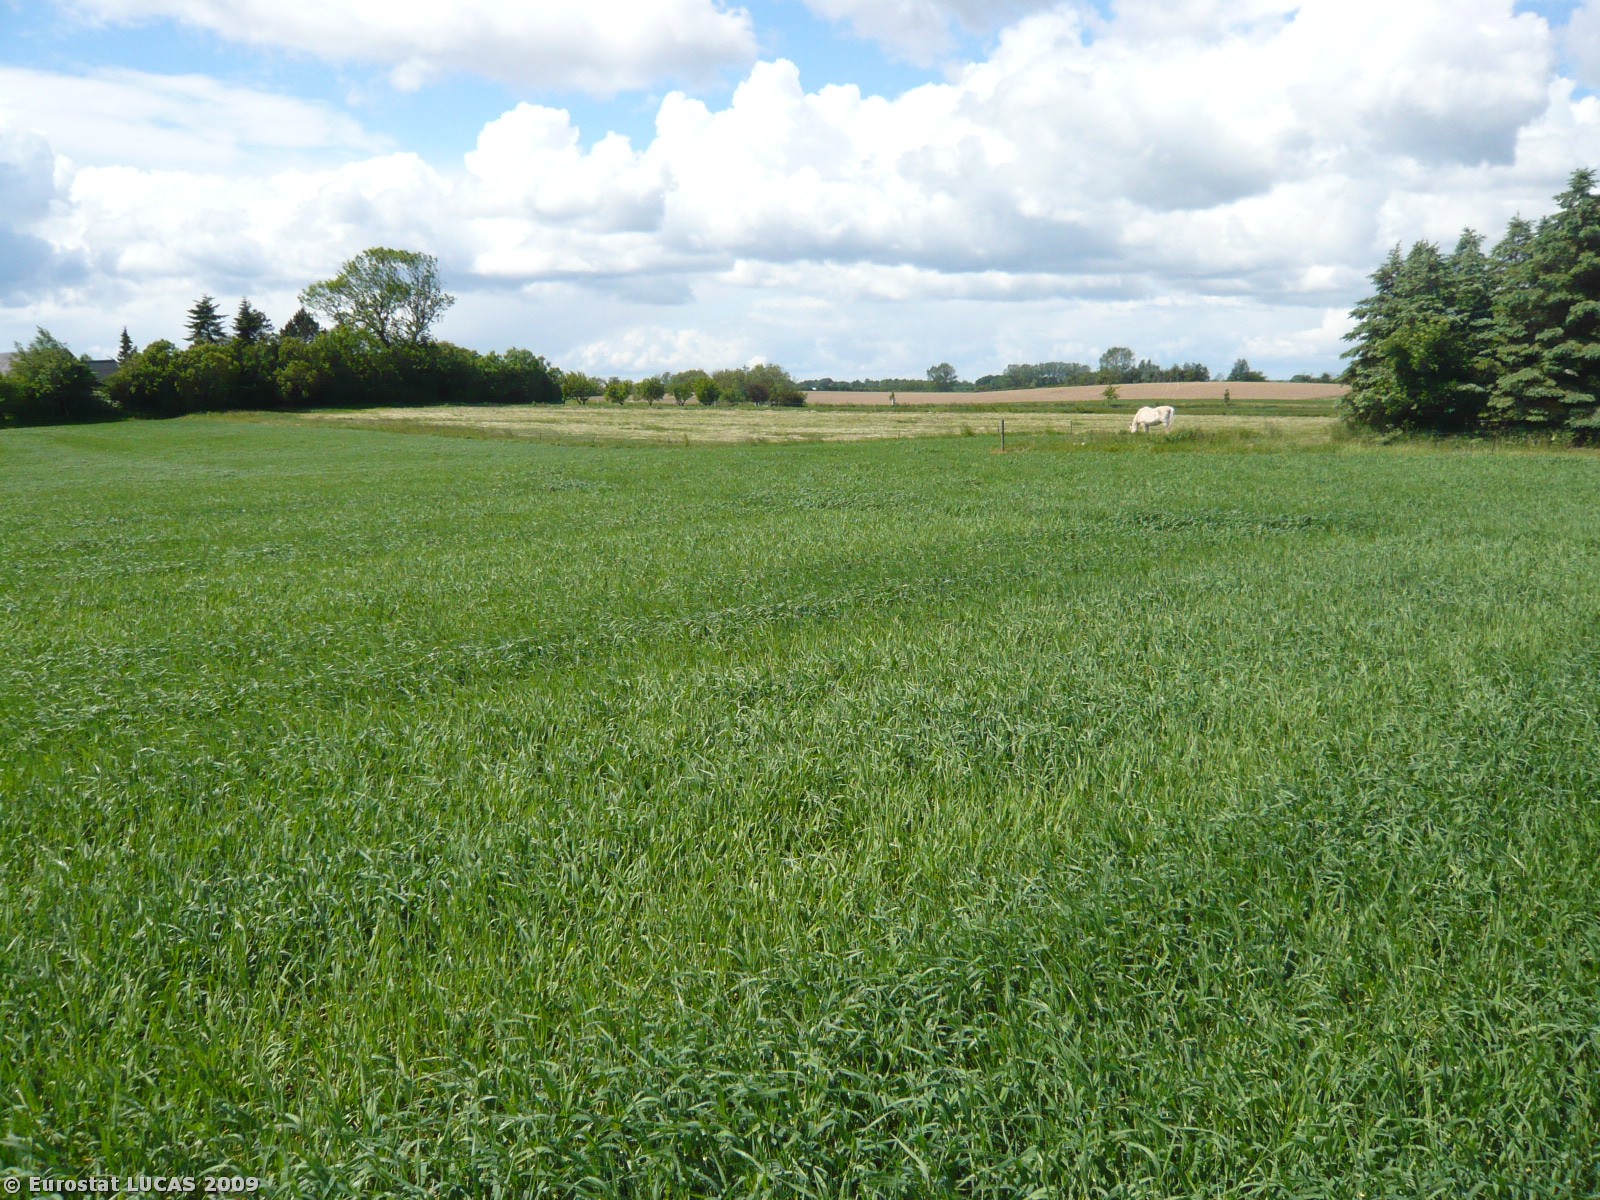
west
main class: Cropland
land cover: Barley
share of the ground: > 75 %
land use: Agriculture (excluding fallow land and kitchen gardens)
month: June
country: DK
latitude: 55.2071
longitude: 11.5859
